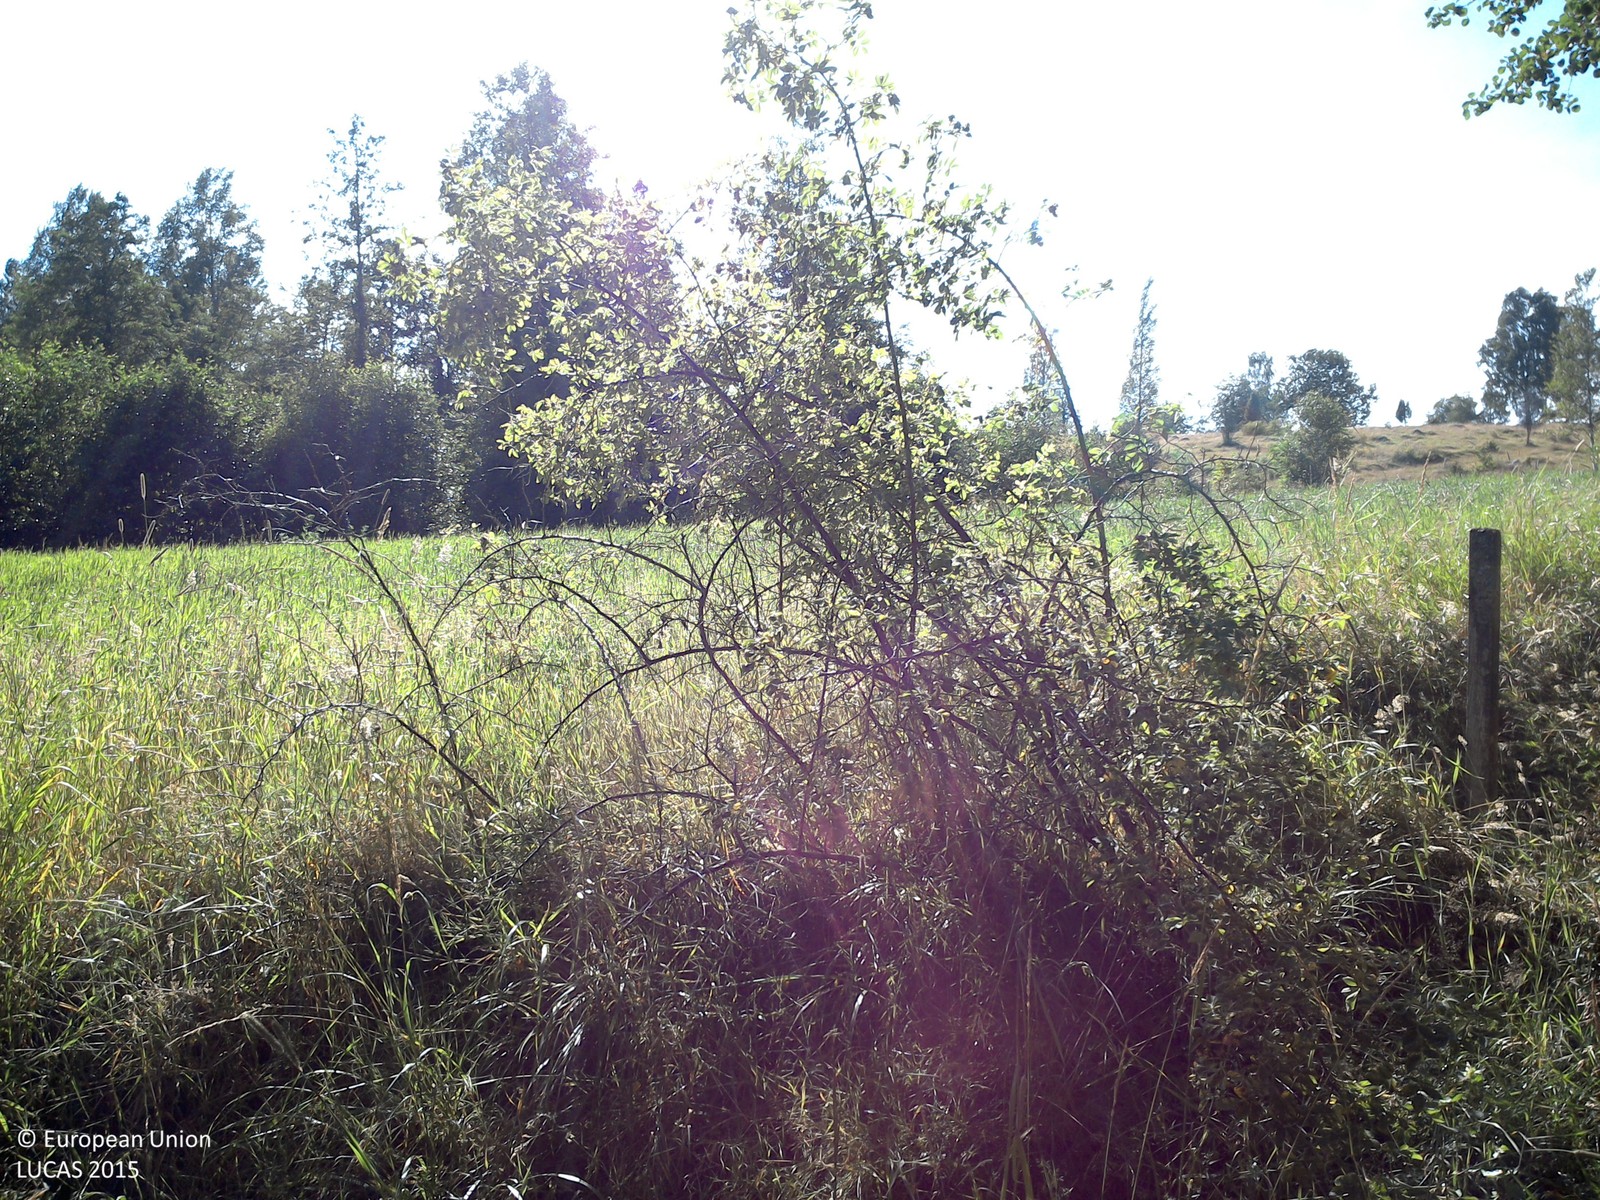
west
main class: Woodland
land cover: Broadleaved woodland
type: boreal forest
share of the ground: 50 - 75 %
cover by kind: broadleaved forest trees 55 %, herbaceous plants 40 %, coniferous forest trees 5 %
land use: Forestry
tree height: > 5 m
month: August
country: SE
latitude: 57.9604
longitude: 15.5560
